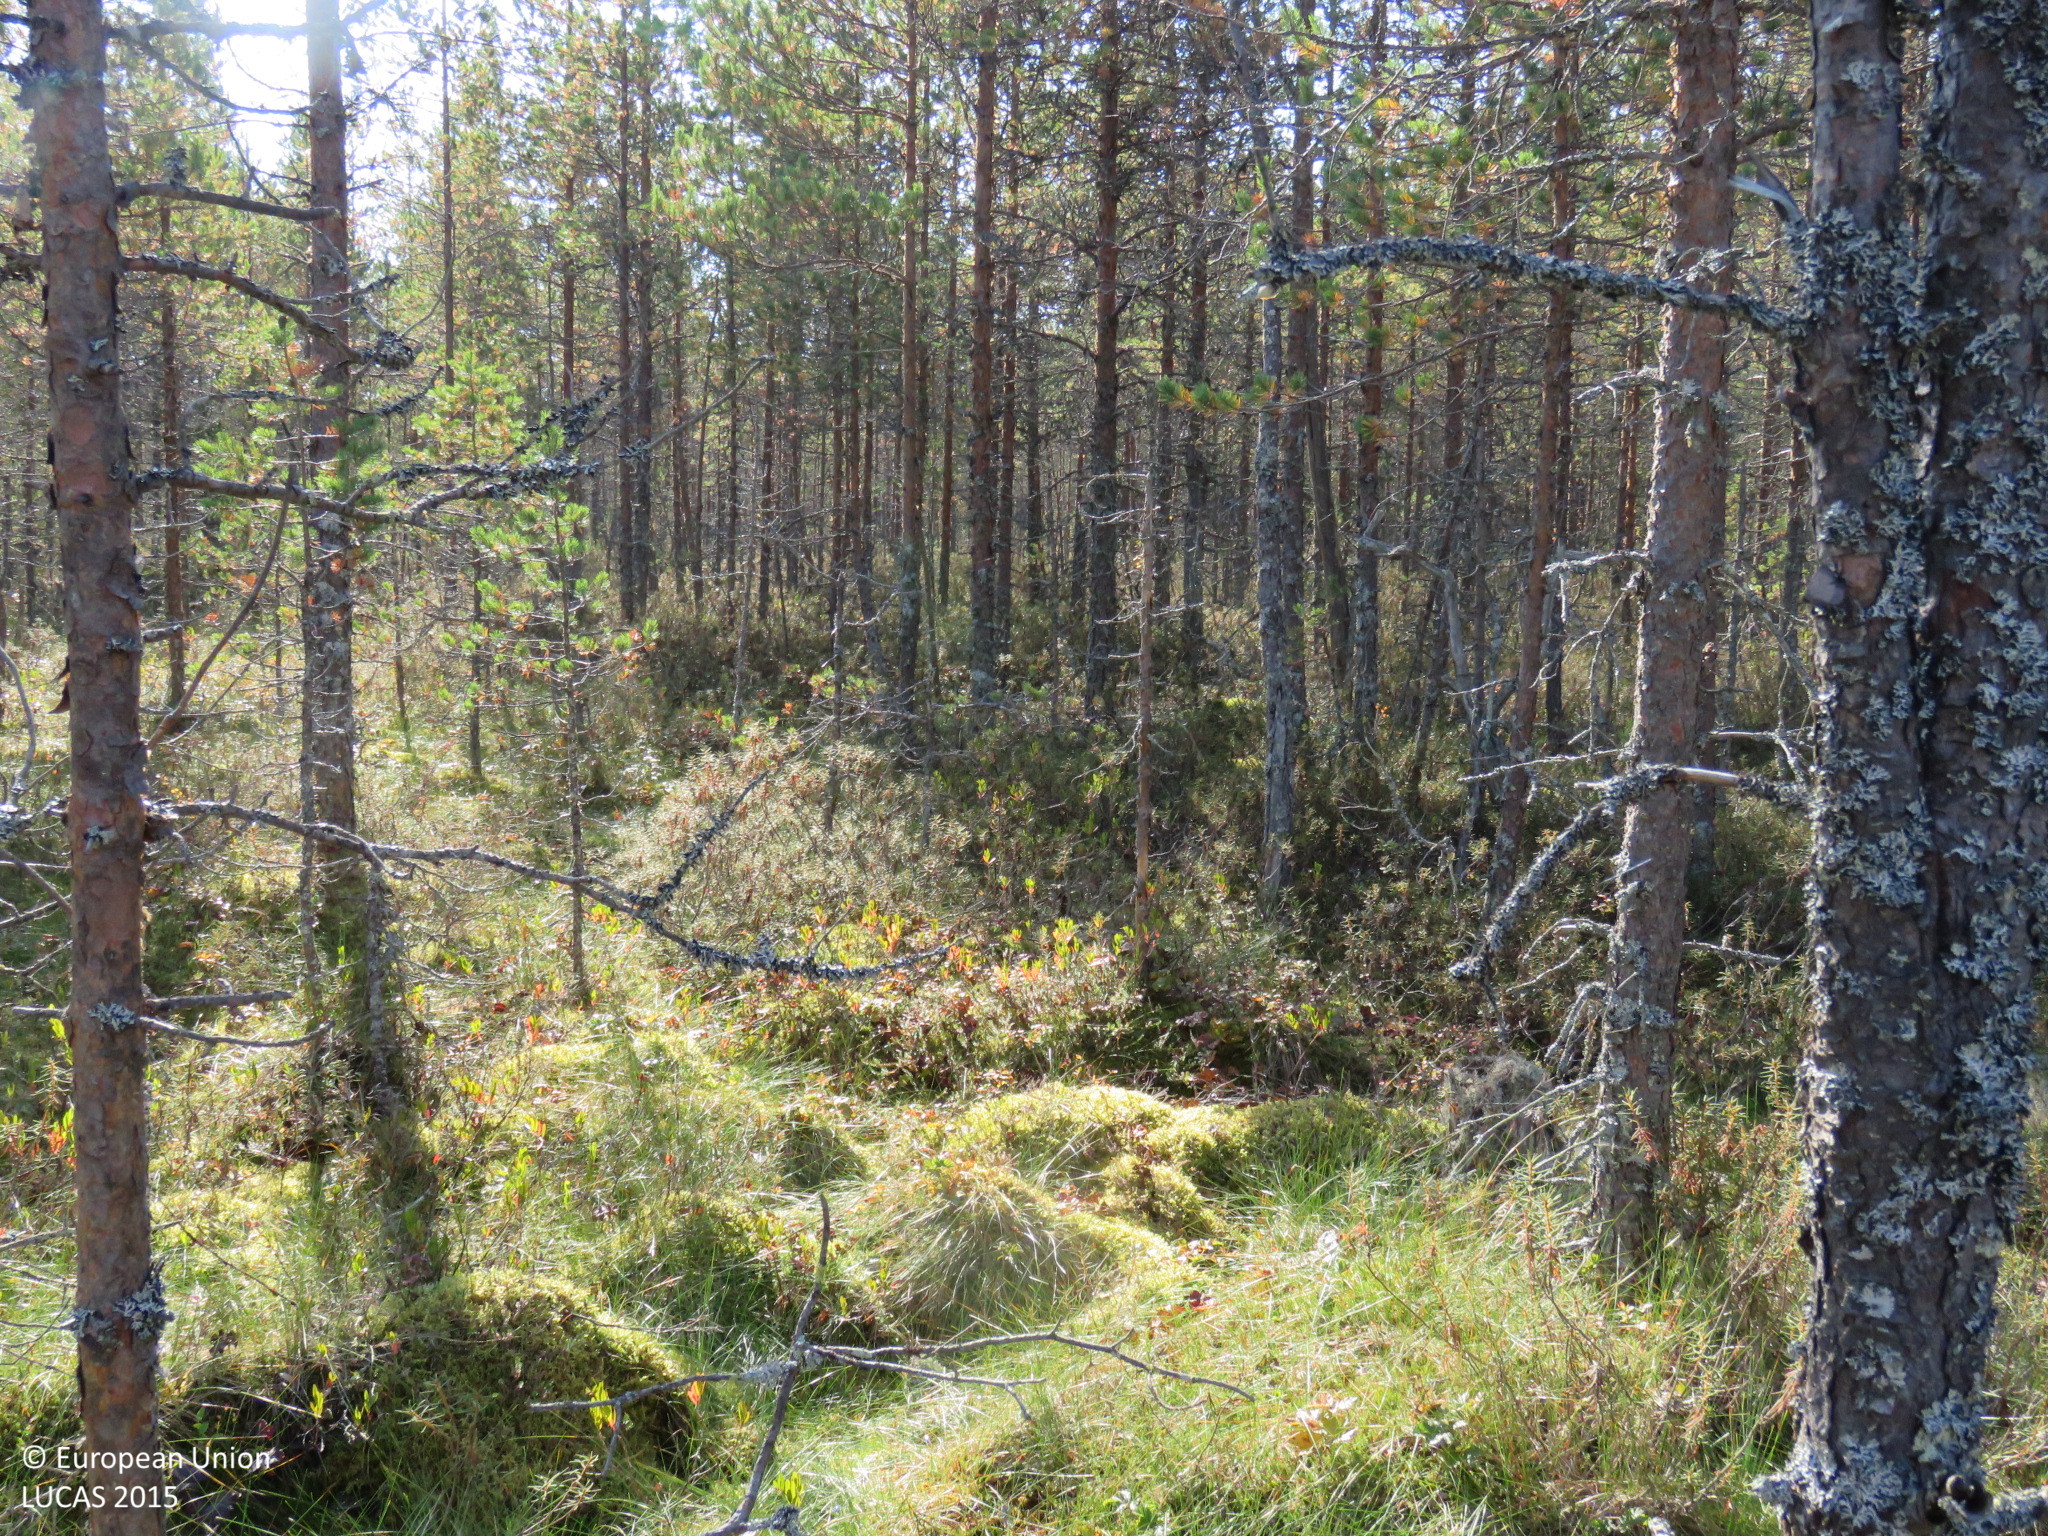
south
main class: Woodland
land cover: Pine dominated coniferous woodland
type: mire and swamp forests
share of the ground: 50 - 75 %
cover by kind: coniferous forest trees 60 %, herbaceous plants 30 %, shrubs 5 %, lichens and mosses 5 %
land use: Forestry
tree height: > 5 m
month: September
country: FI
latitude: 64.8865
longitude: 26.4313
